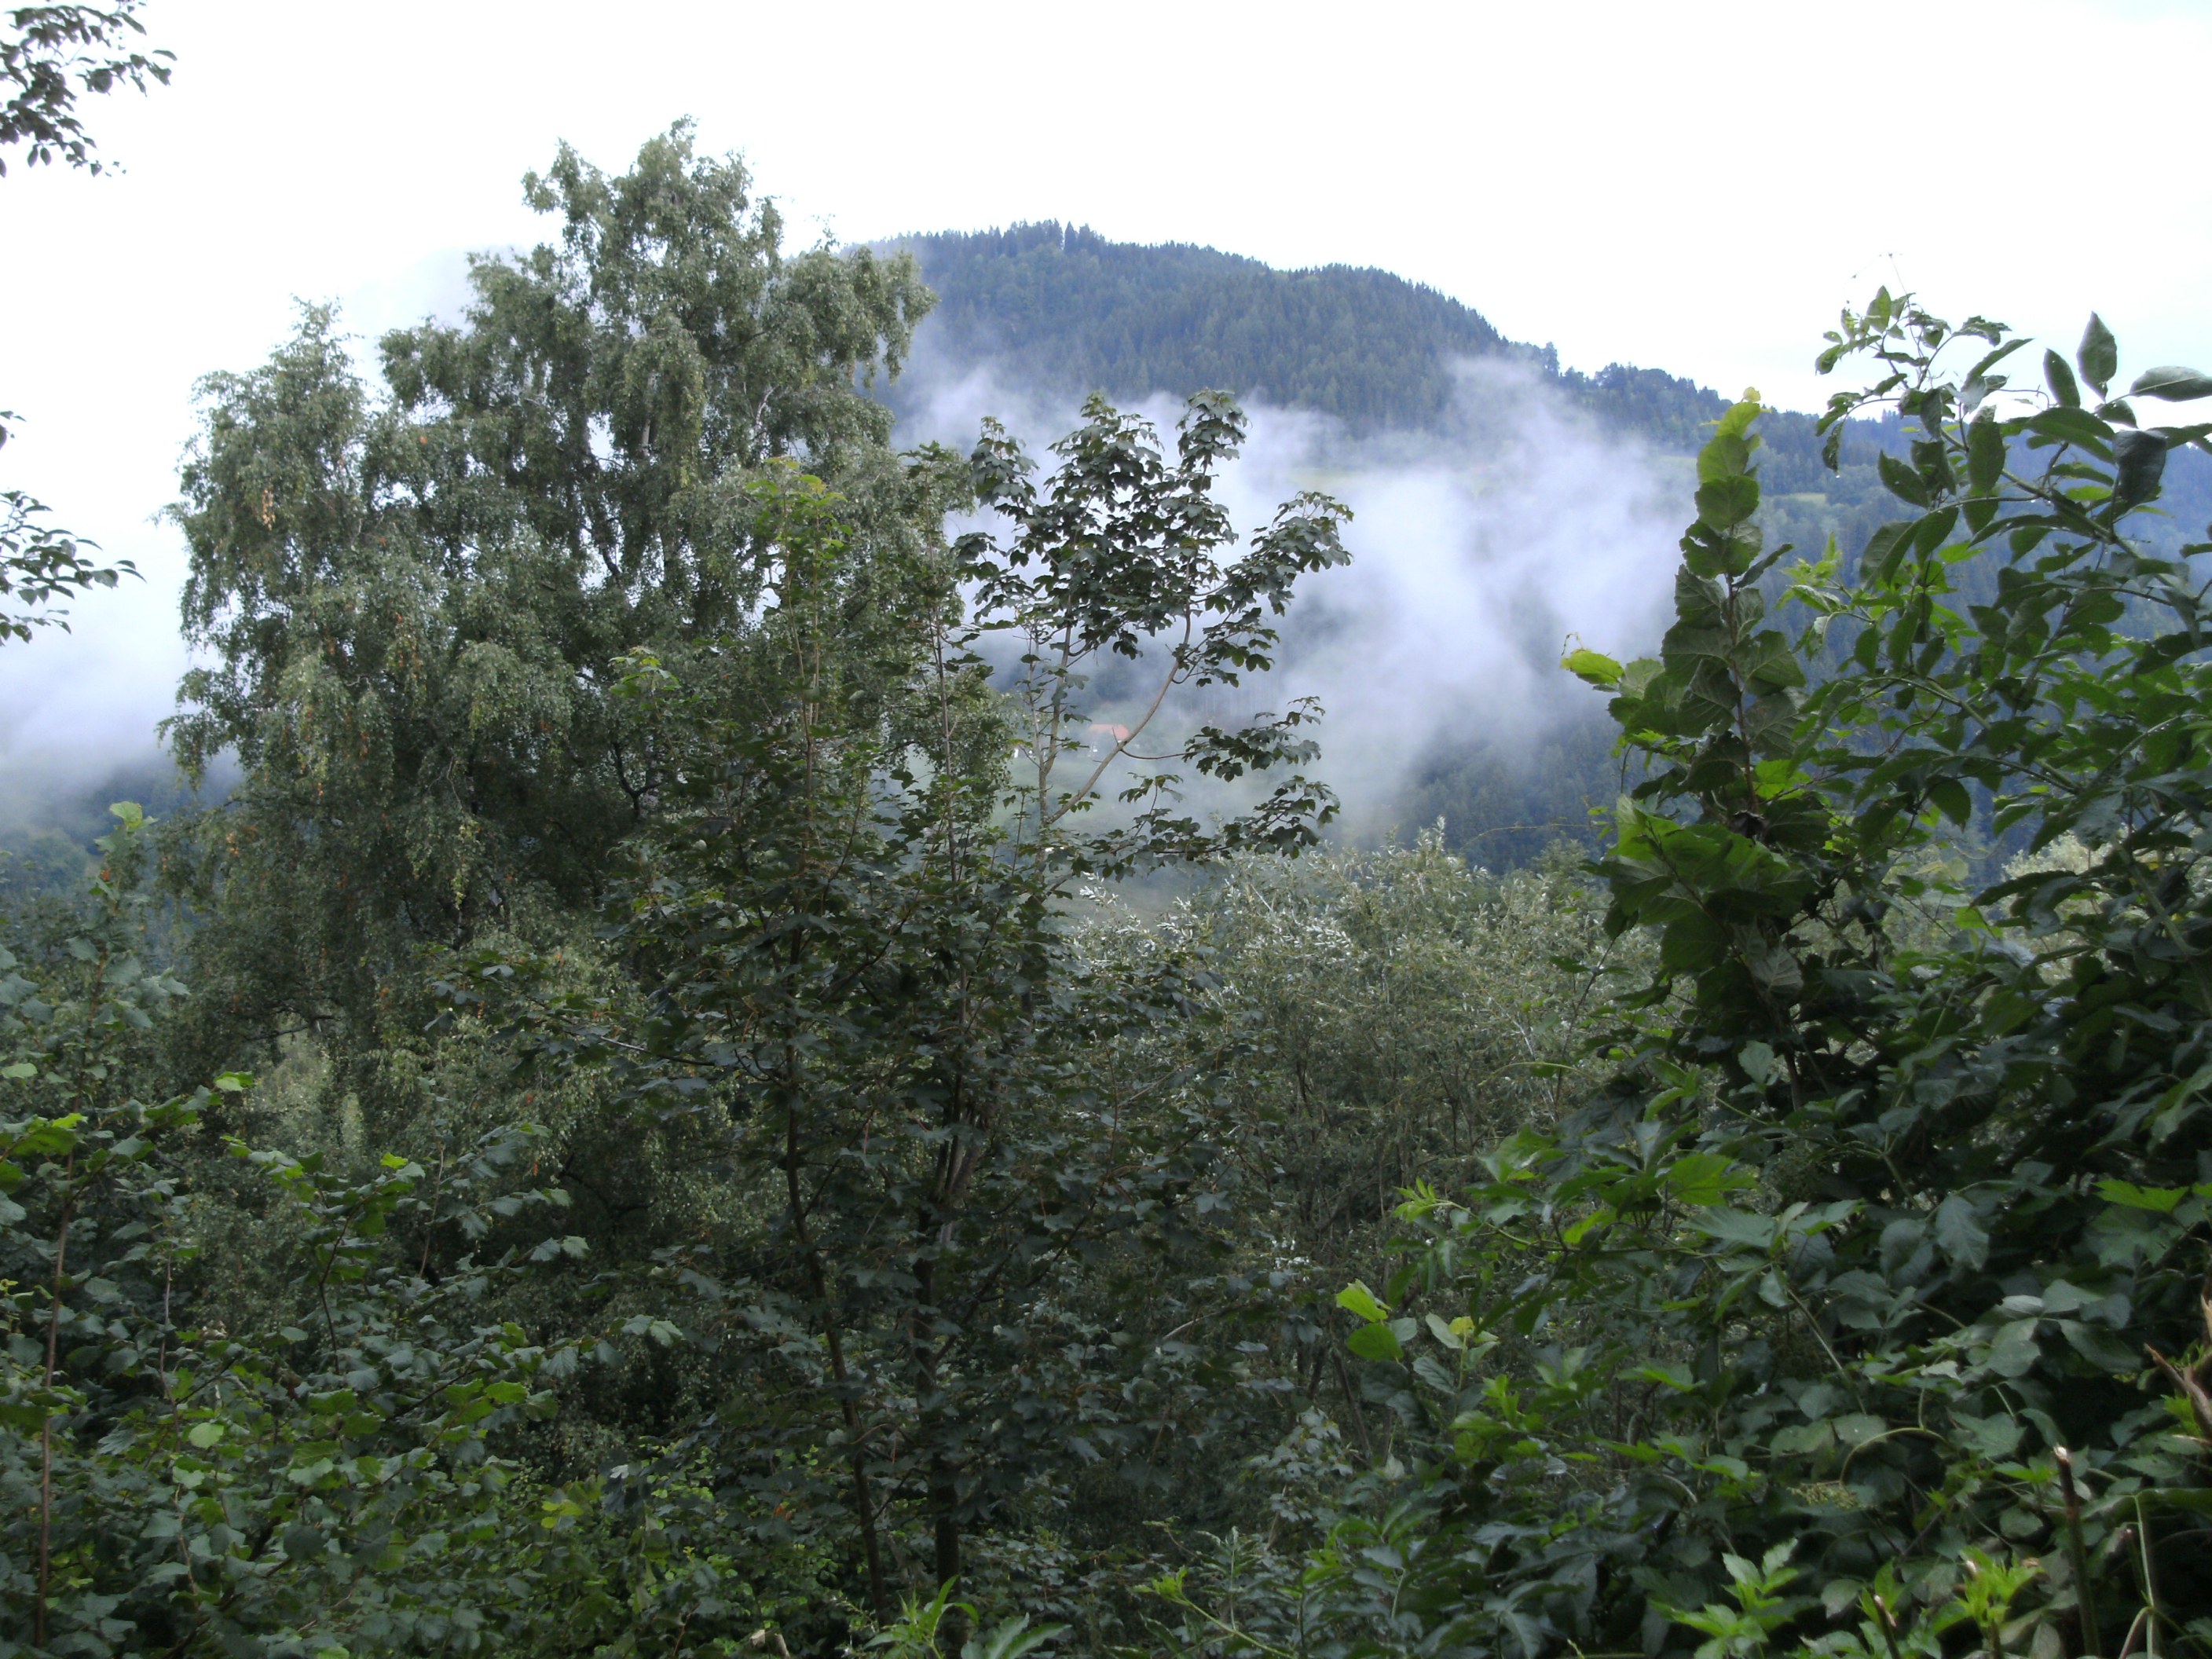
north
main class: Grassland
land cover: Grassland with sparse tree/shrub cover
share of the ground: > 75 %
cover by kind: herbaceous plants 95 %, broadleaved forest trees 5 %
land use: Forestry
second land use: Residential
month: July
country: AT
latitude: 46.8707
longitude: 14.8921
